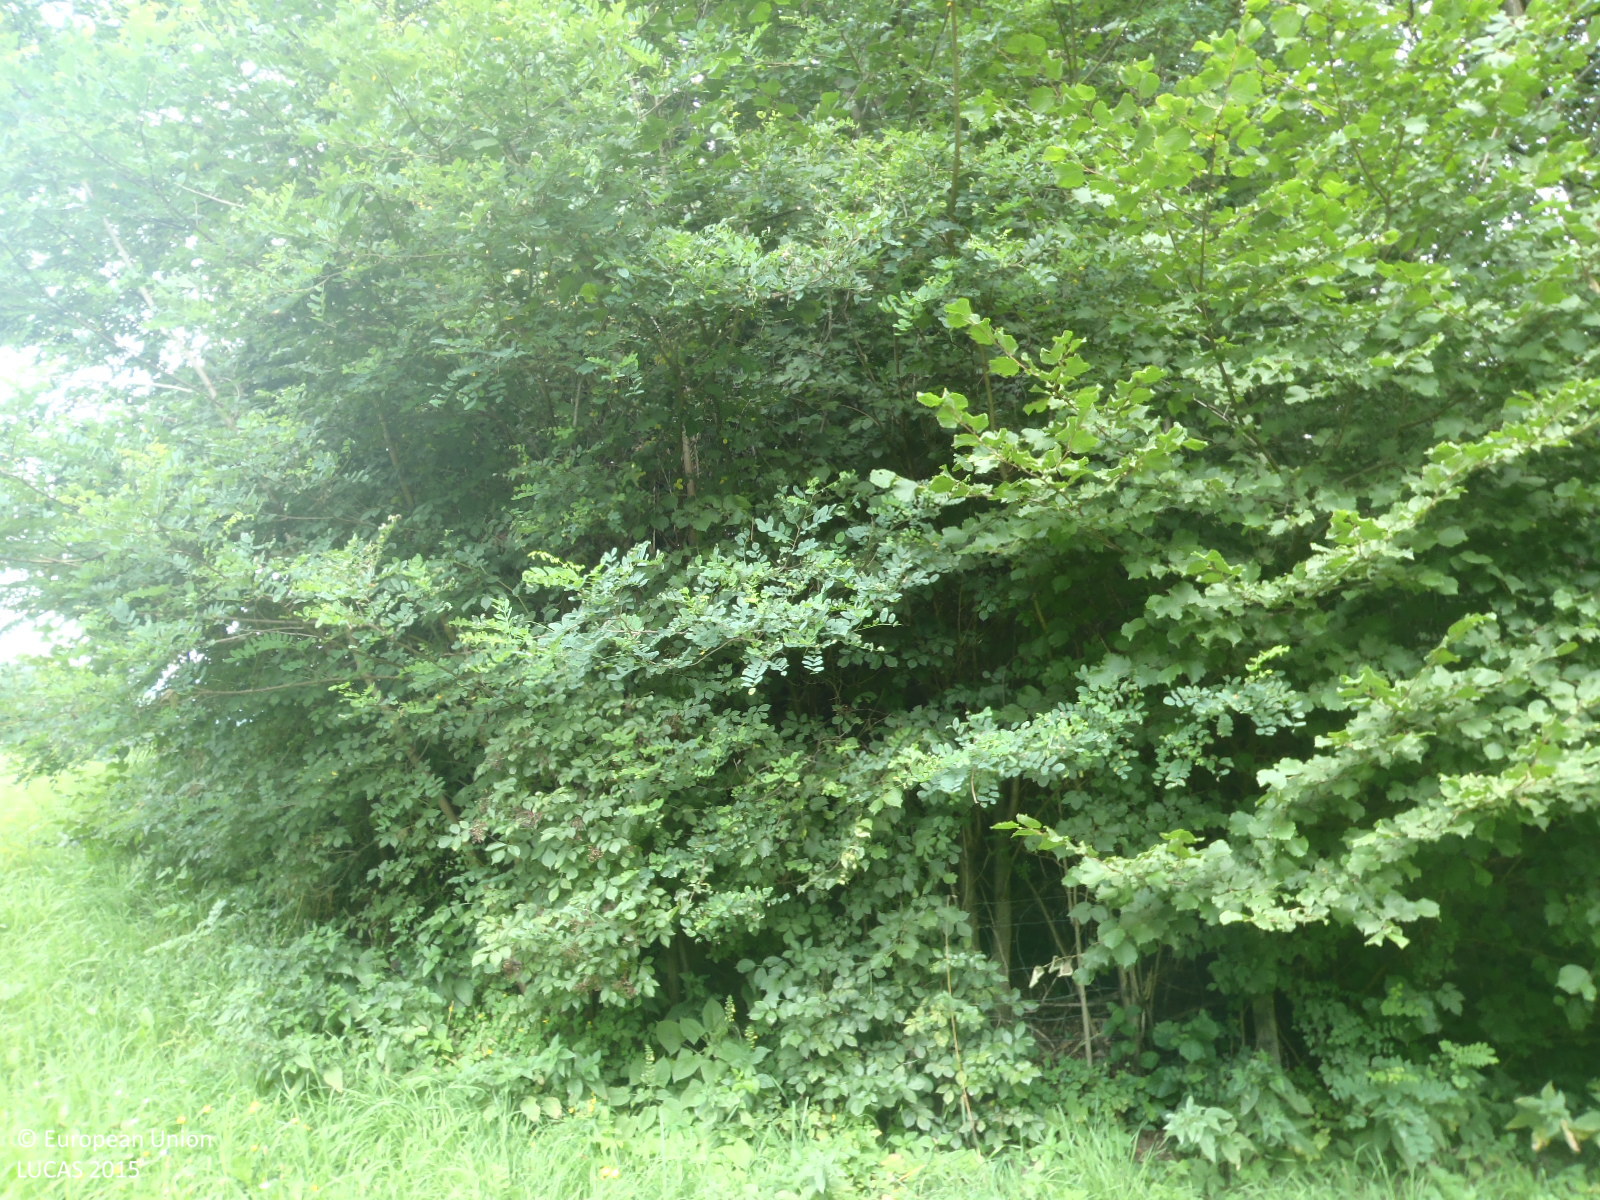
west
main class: Grassland
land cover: Grassland without tree/shrub cover
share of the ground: > 75 %
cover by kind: herbaceous plants 100 %
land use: Agriculture (excluding fallow land and kitchen gardens)
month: August
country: AT
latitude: 46.8767
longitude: 12.6612
